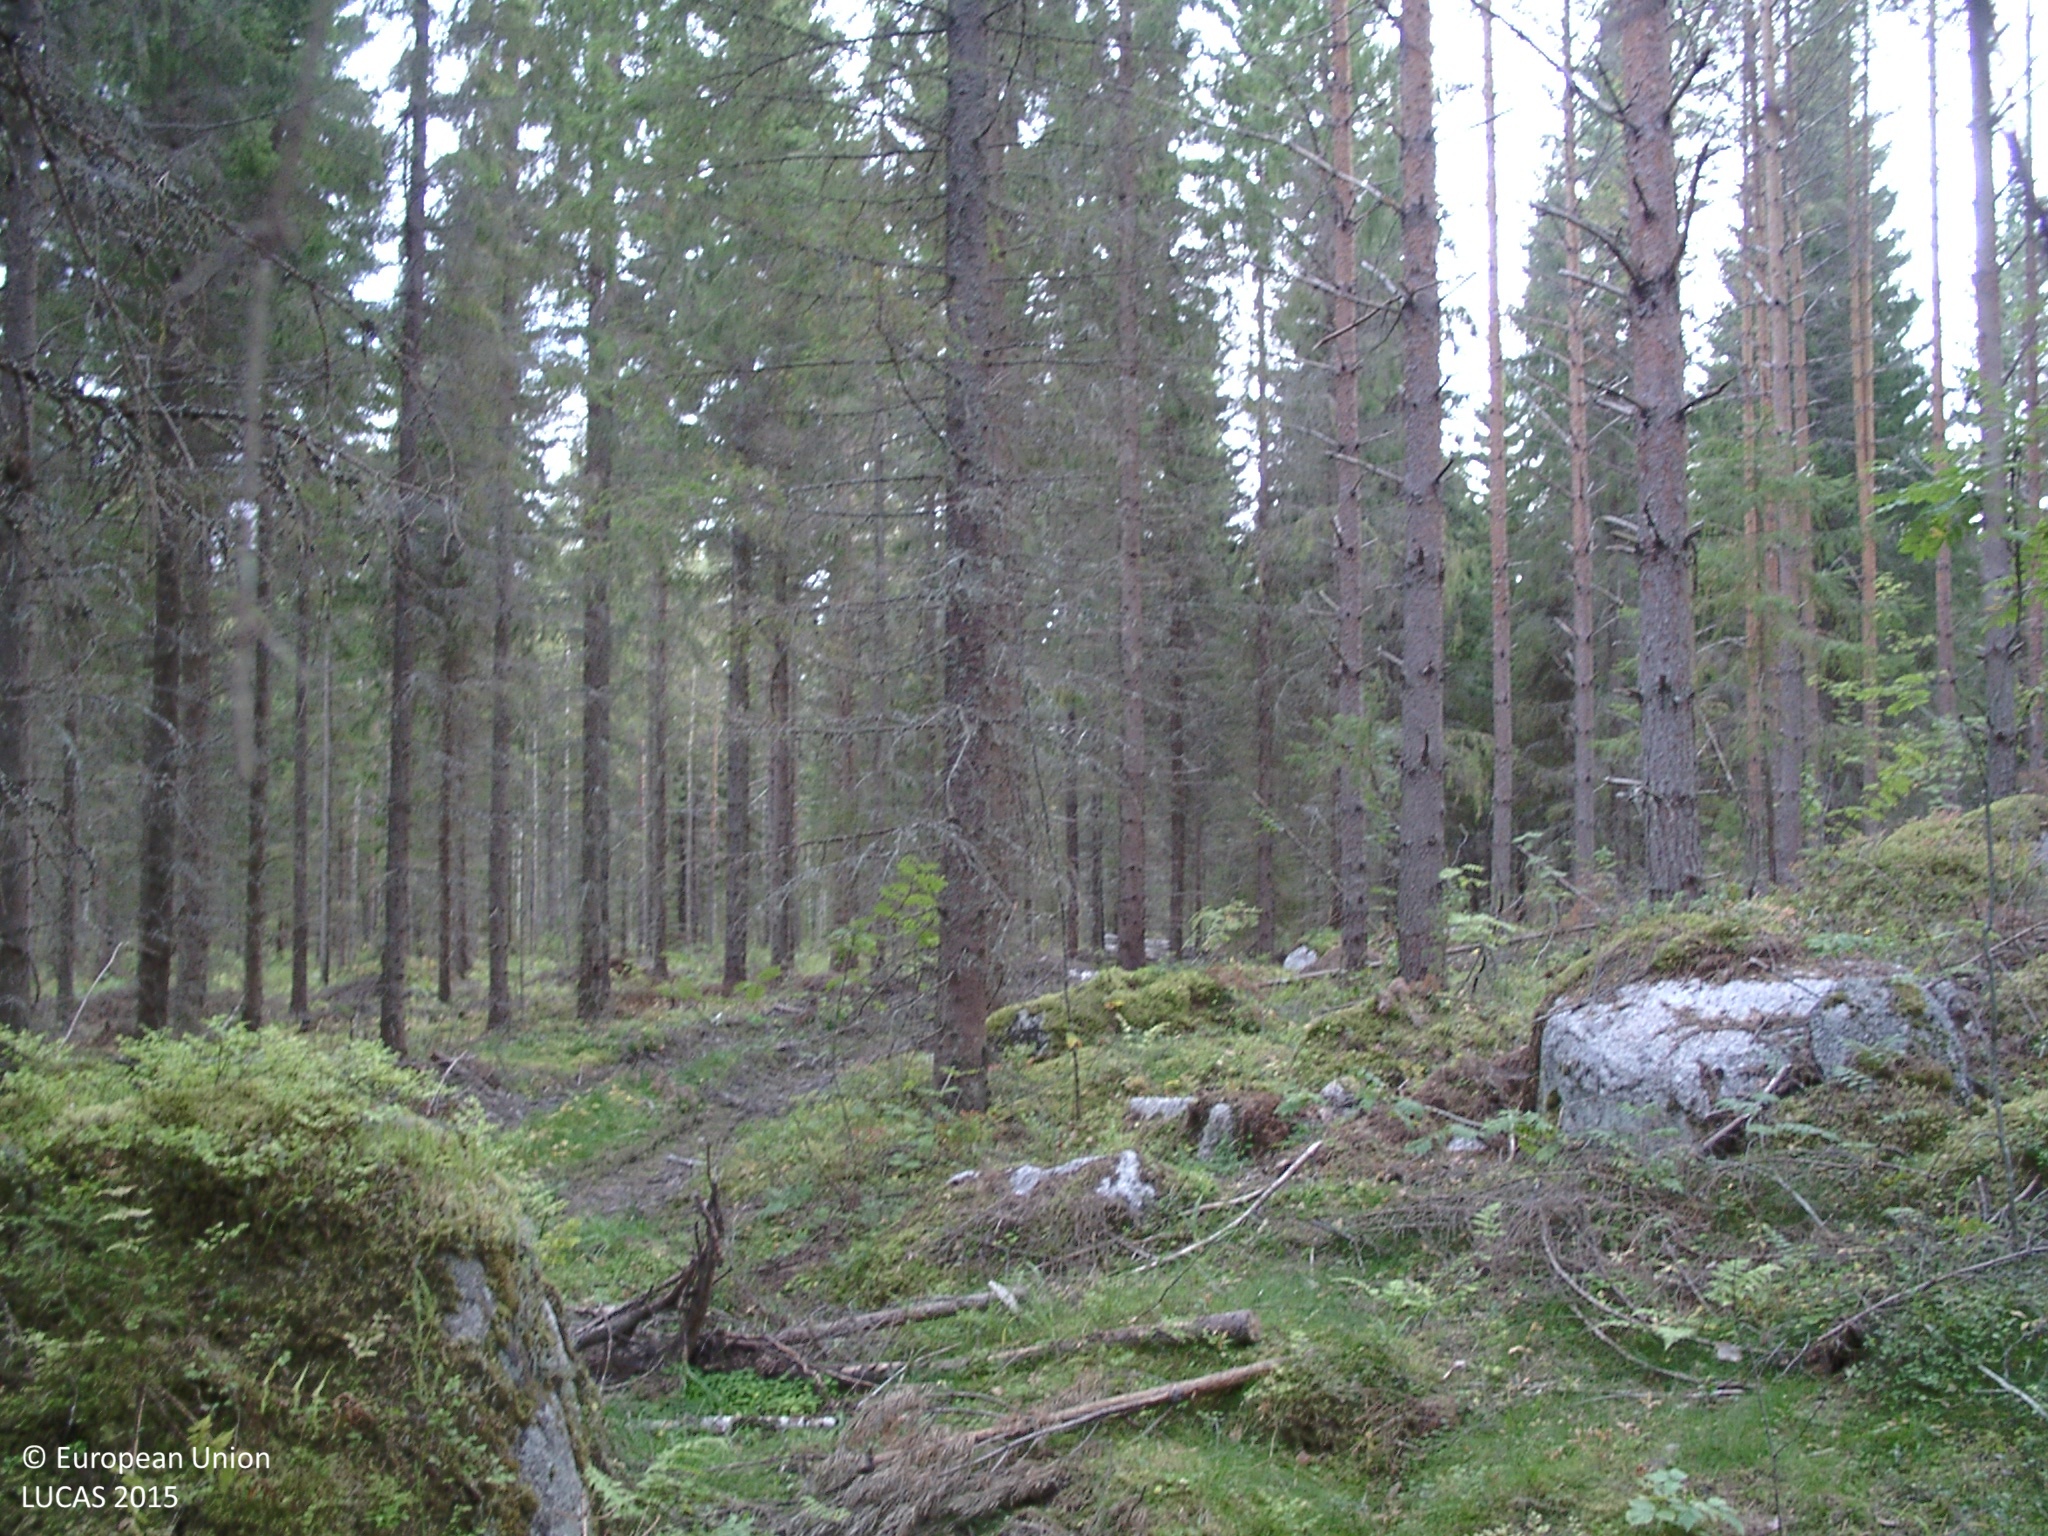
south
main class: Woodland
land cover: Spruce dominated coniferous woodland
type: boreal forest
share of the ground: > 75 %
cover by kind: coniferous forest trees 75 %, unconsolidated bare surface 15 %, lichens and mosses 10 %
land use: Forestry
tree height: > 5 m
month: September
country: FI
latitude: 62.5566
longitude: 25.6949
